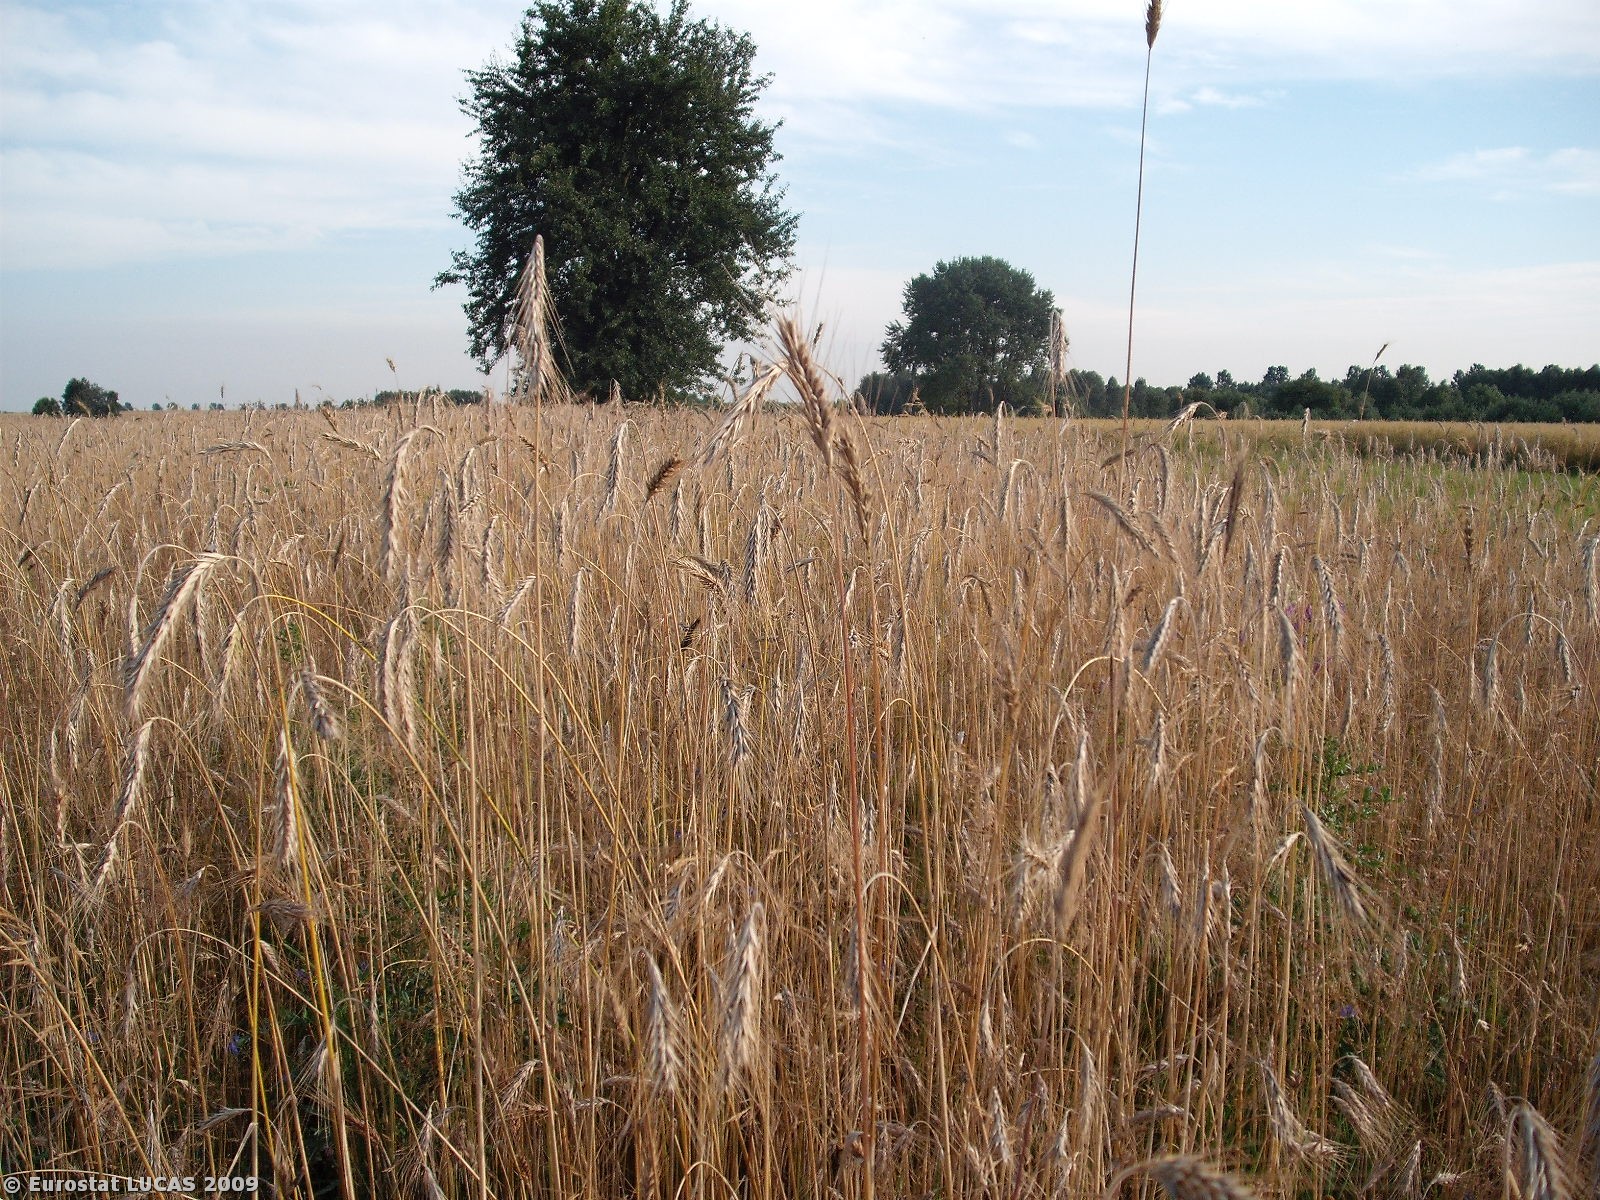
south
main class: Cropland
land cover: Rye
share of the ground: > 75 %
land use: Agriculture (excluding fallow land and kitchen gardens)
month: July
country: PL
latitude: 52.0002
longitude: 21.6624
